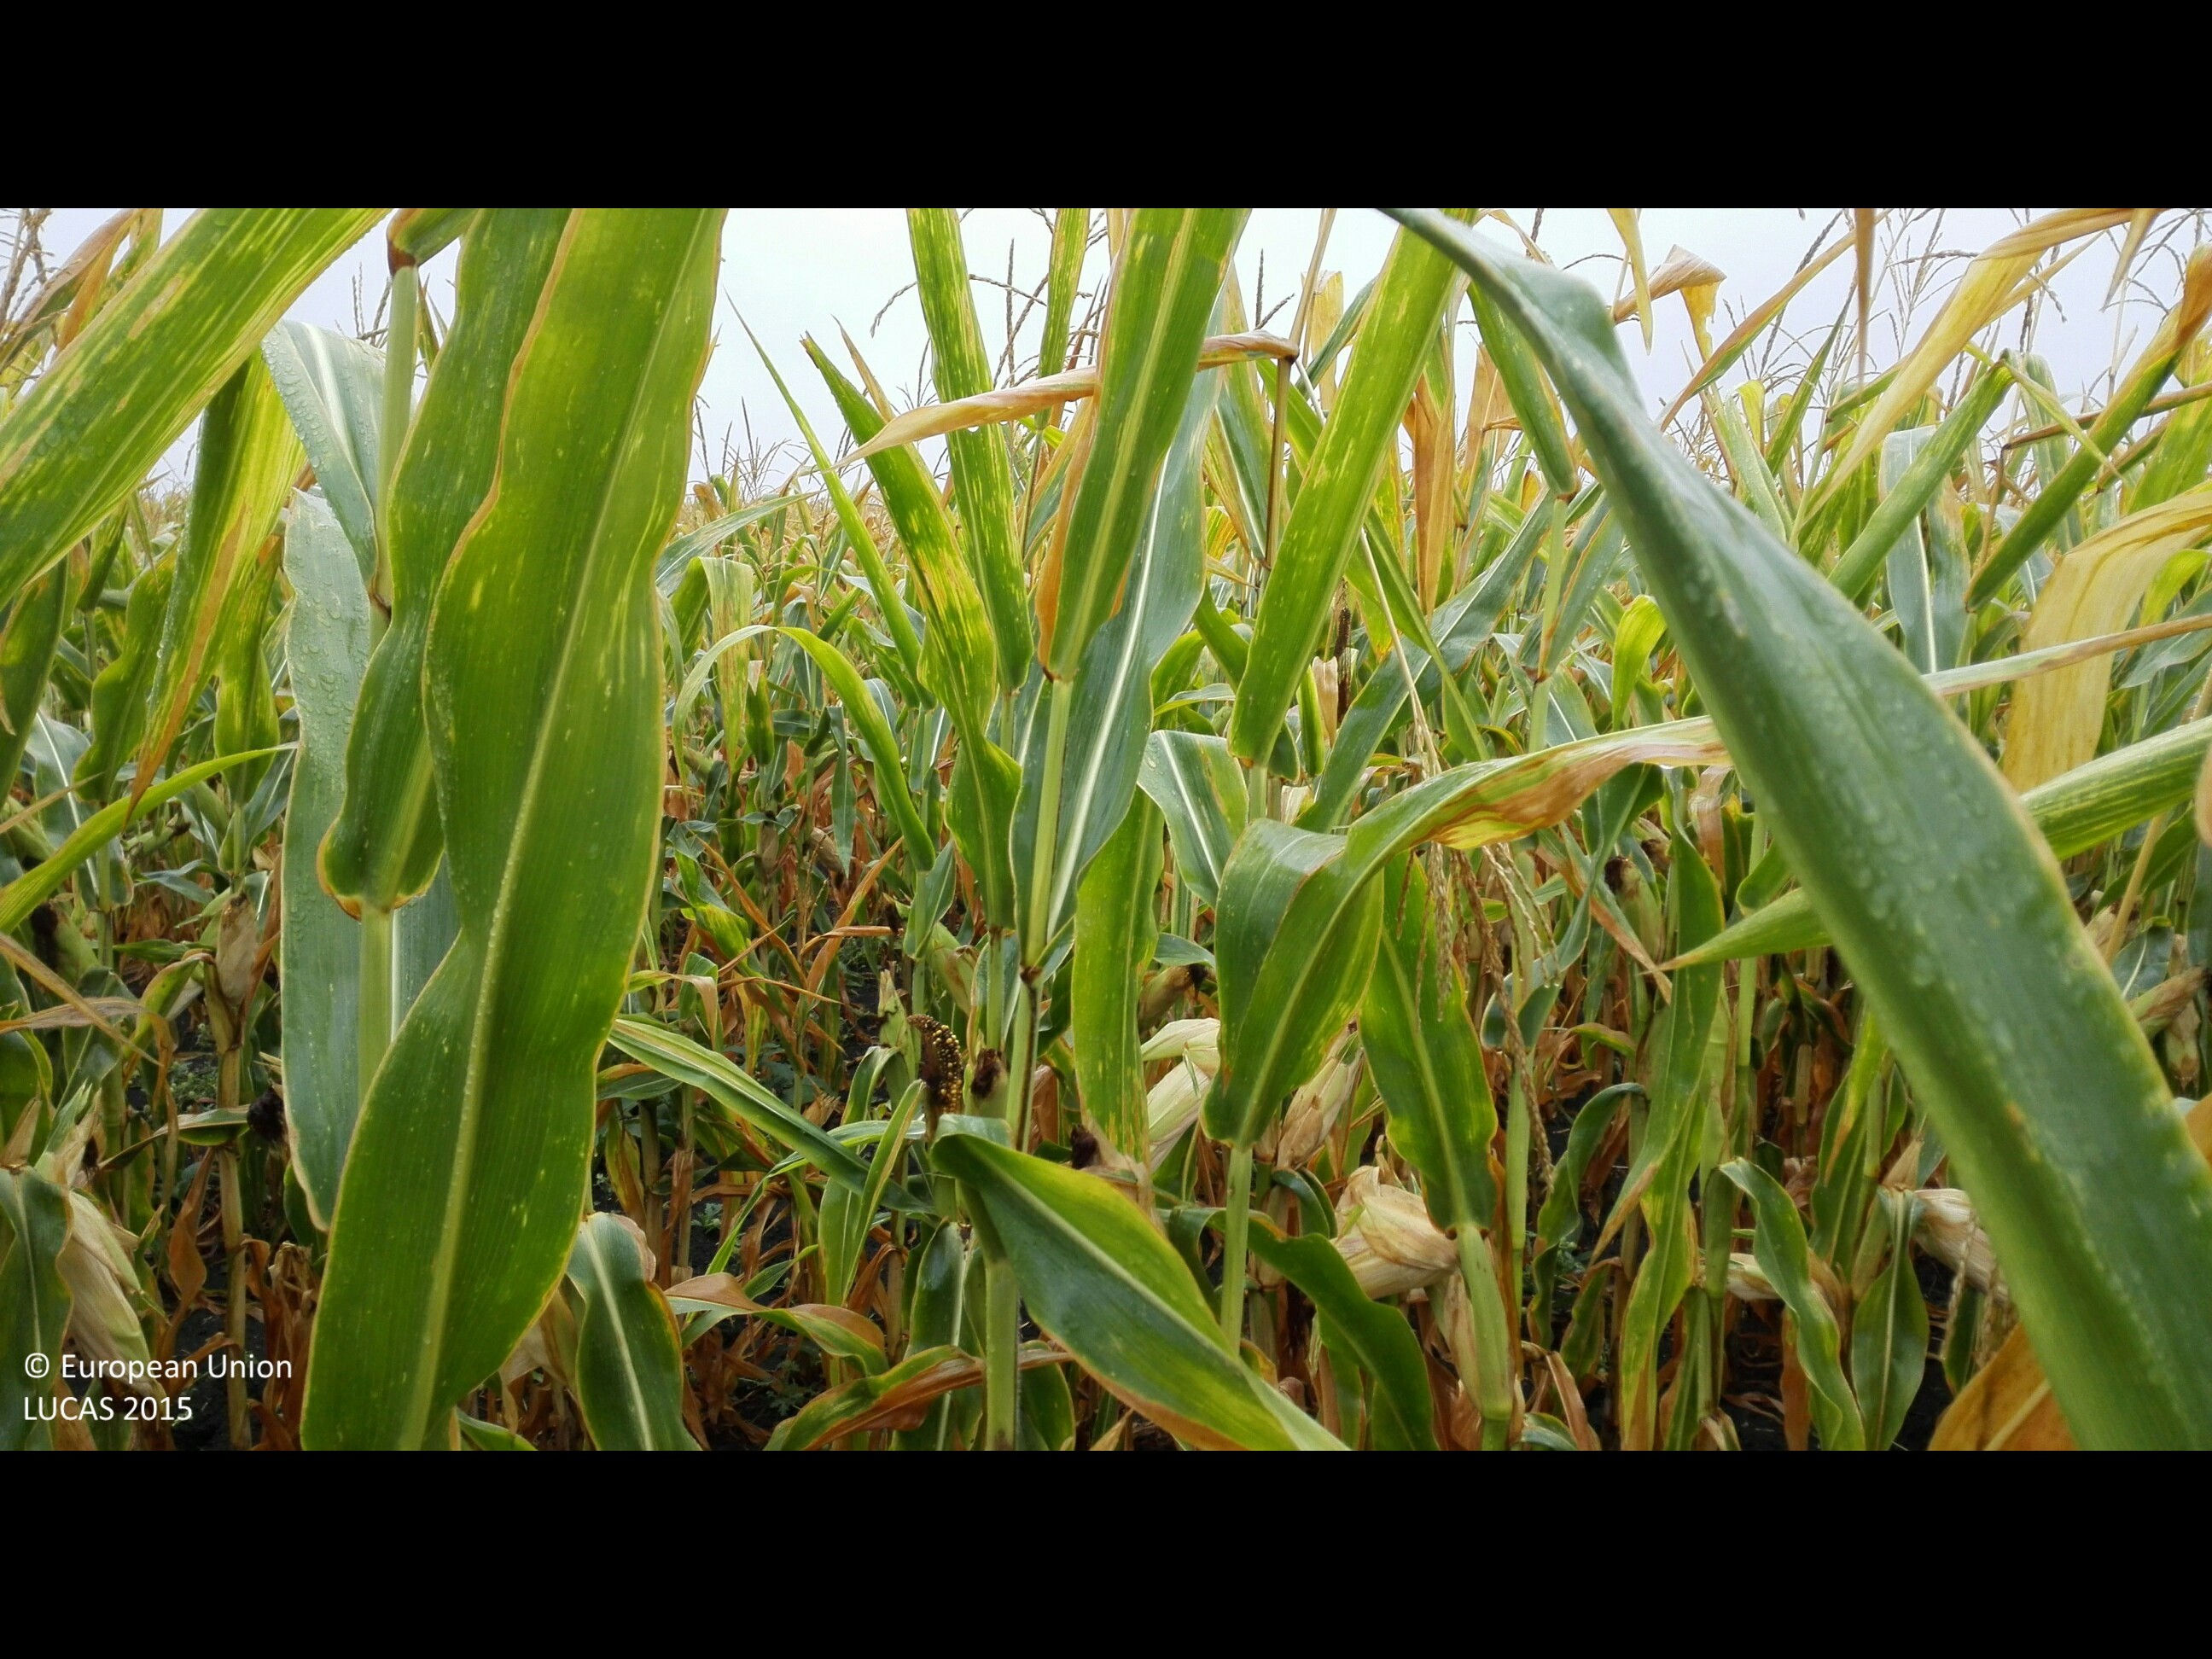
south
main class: Cropland
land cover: Maize
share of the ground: > 75 %
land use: Agriculture (excluding fallow land and kitchen gardens)
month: August
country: HU
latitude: 47.2216
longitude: 21.6513
